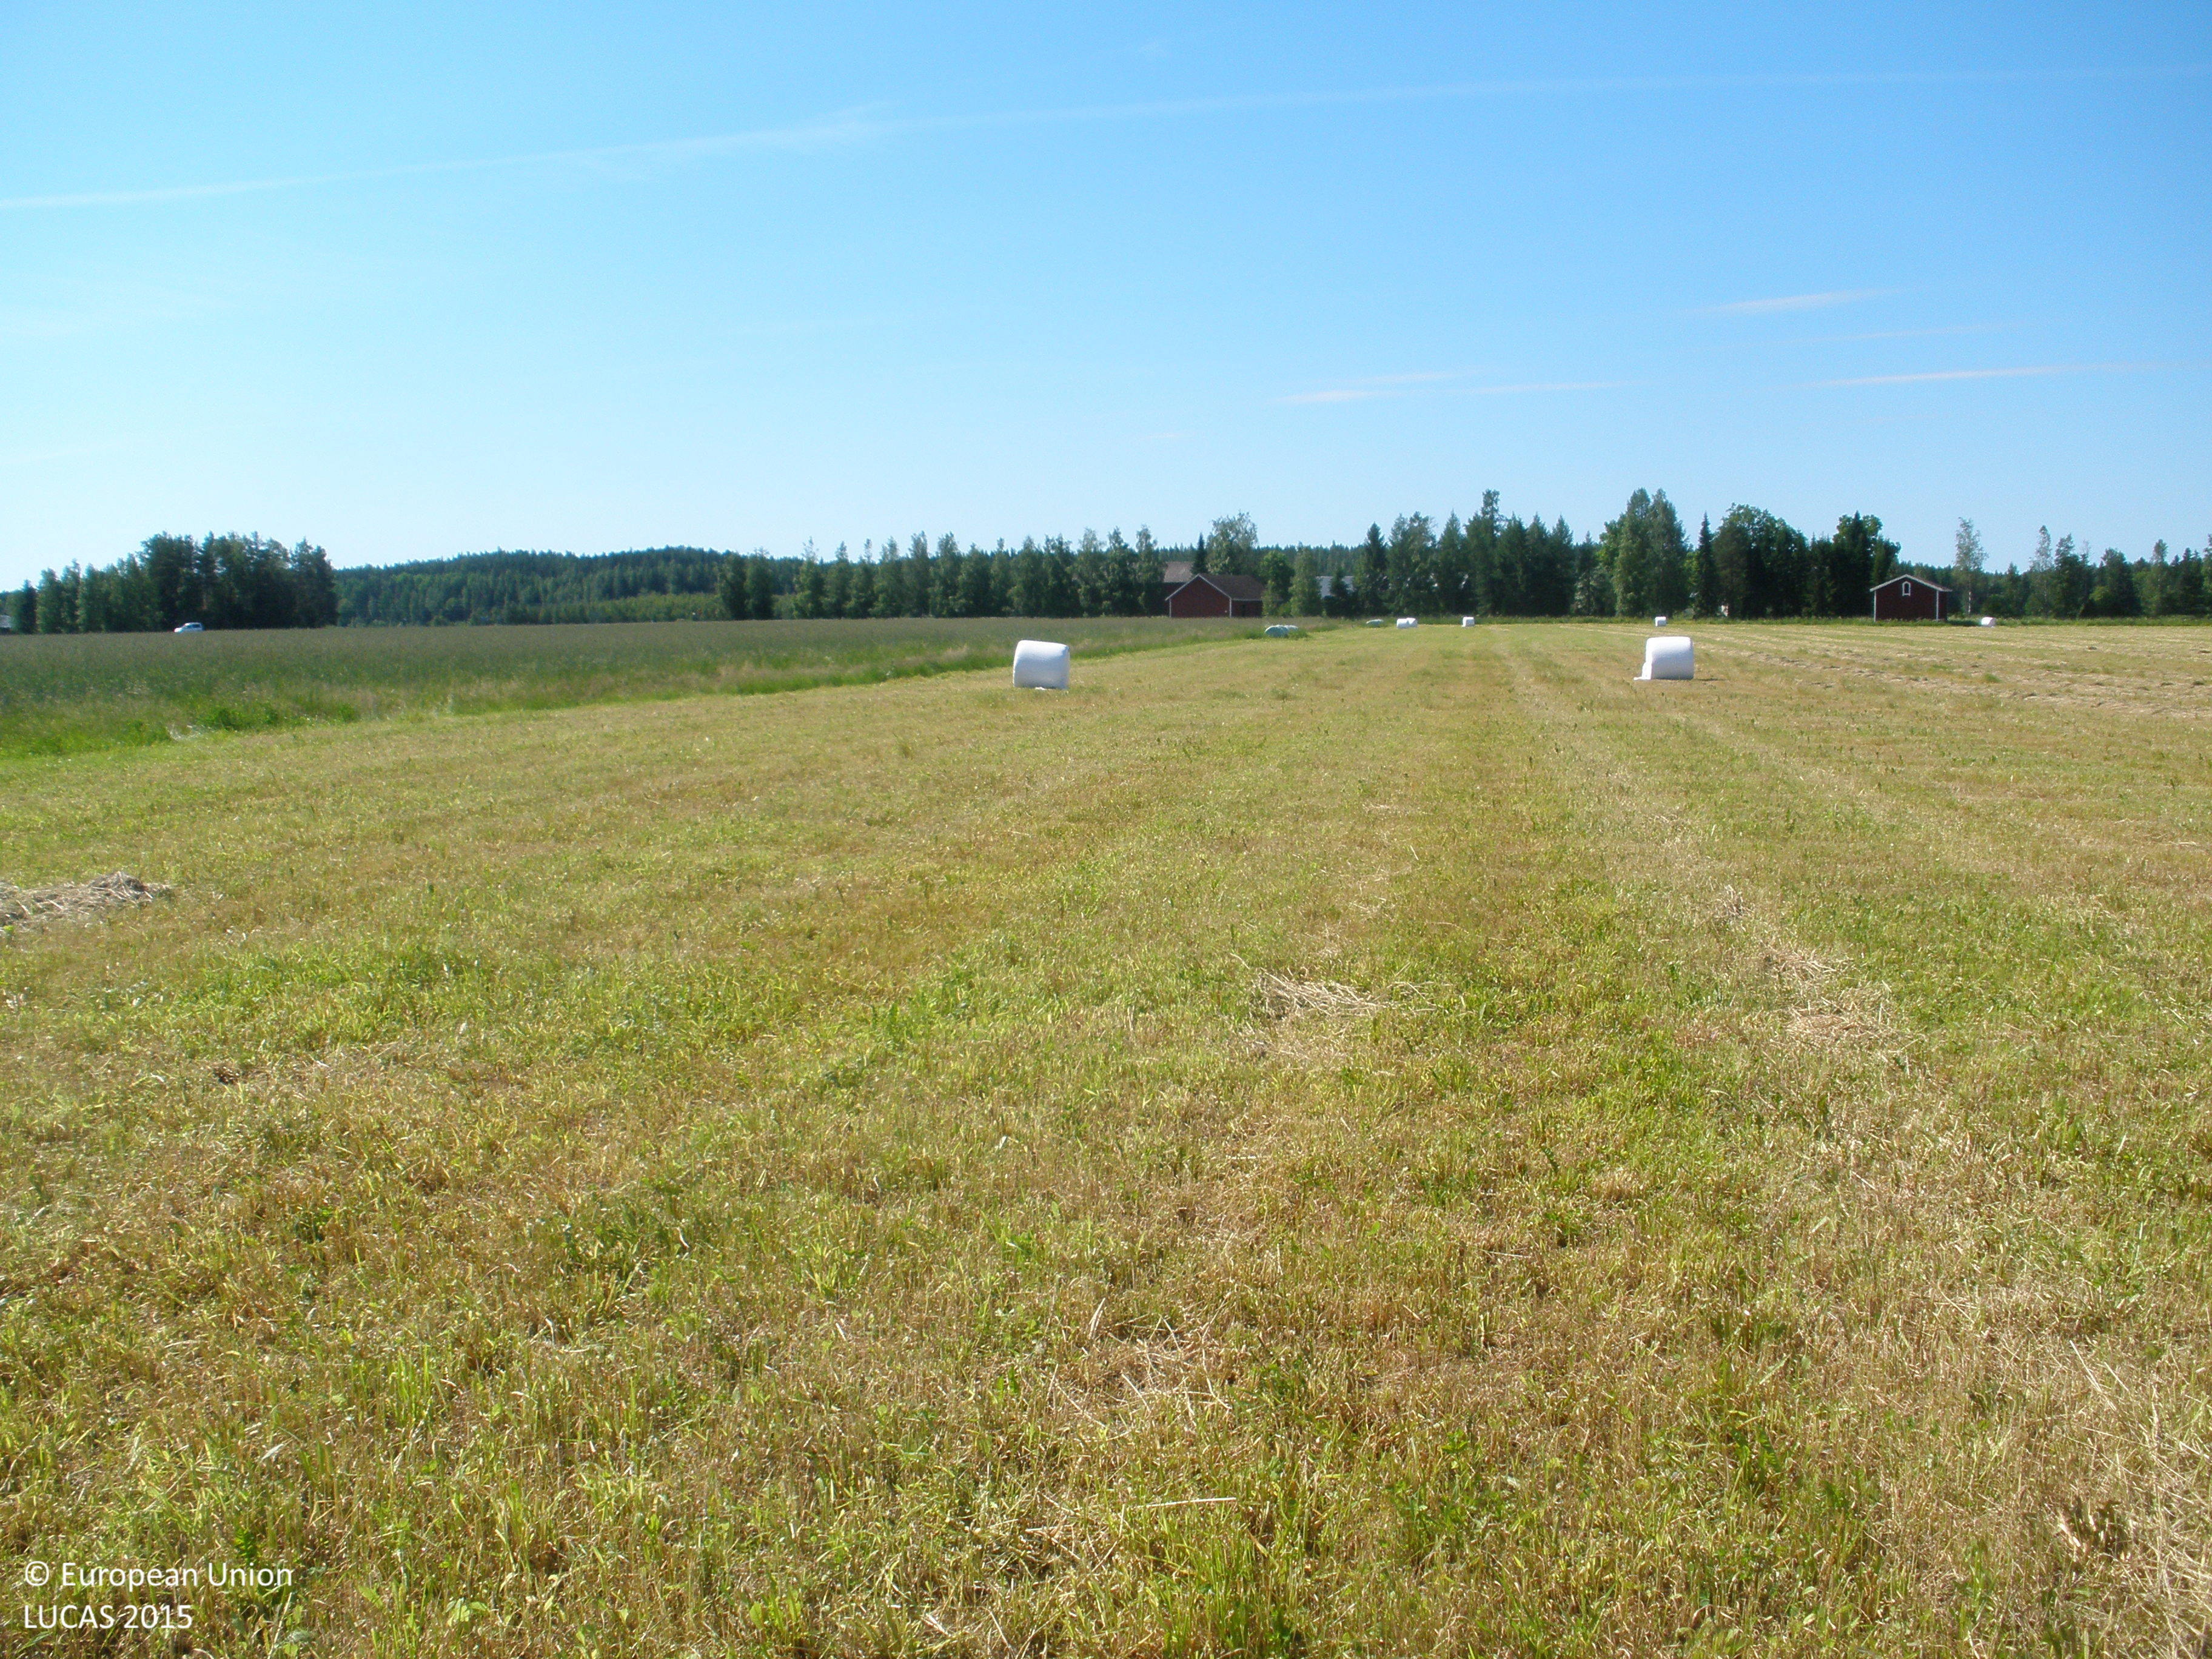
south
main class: Cropland
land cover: Temporary grasslands
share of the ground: > 75 %
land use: Agriculture (excluding fallow land and kitchen gardens)
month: July
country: FI
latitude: 61.1103
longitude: 23.6110
